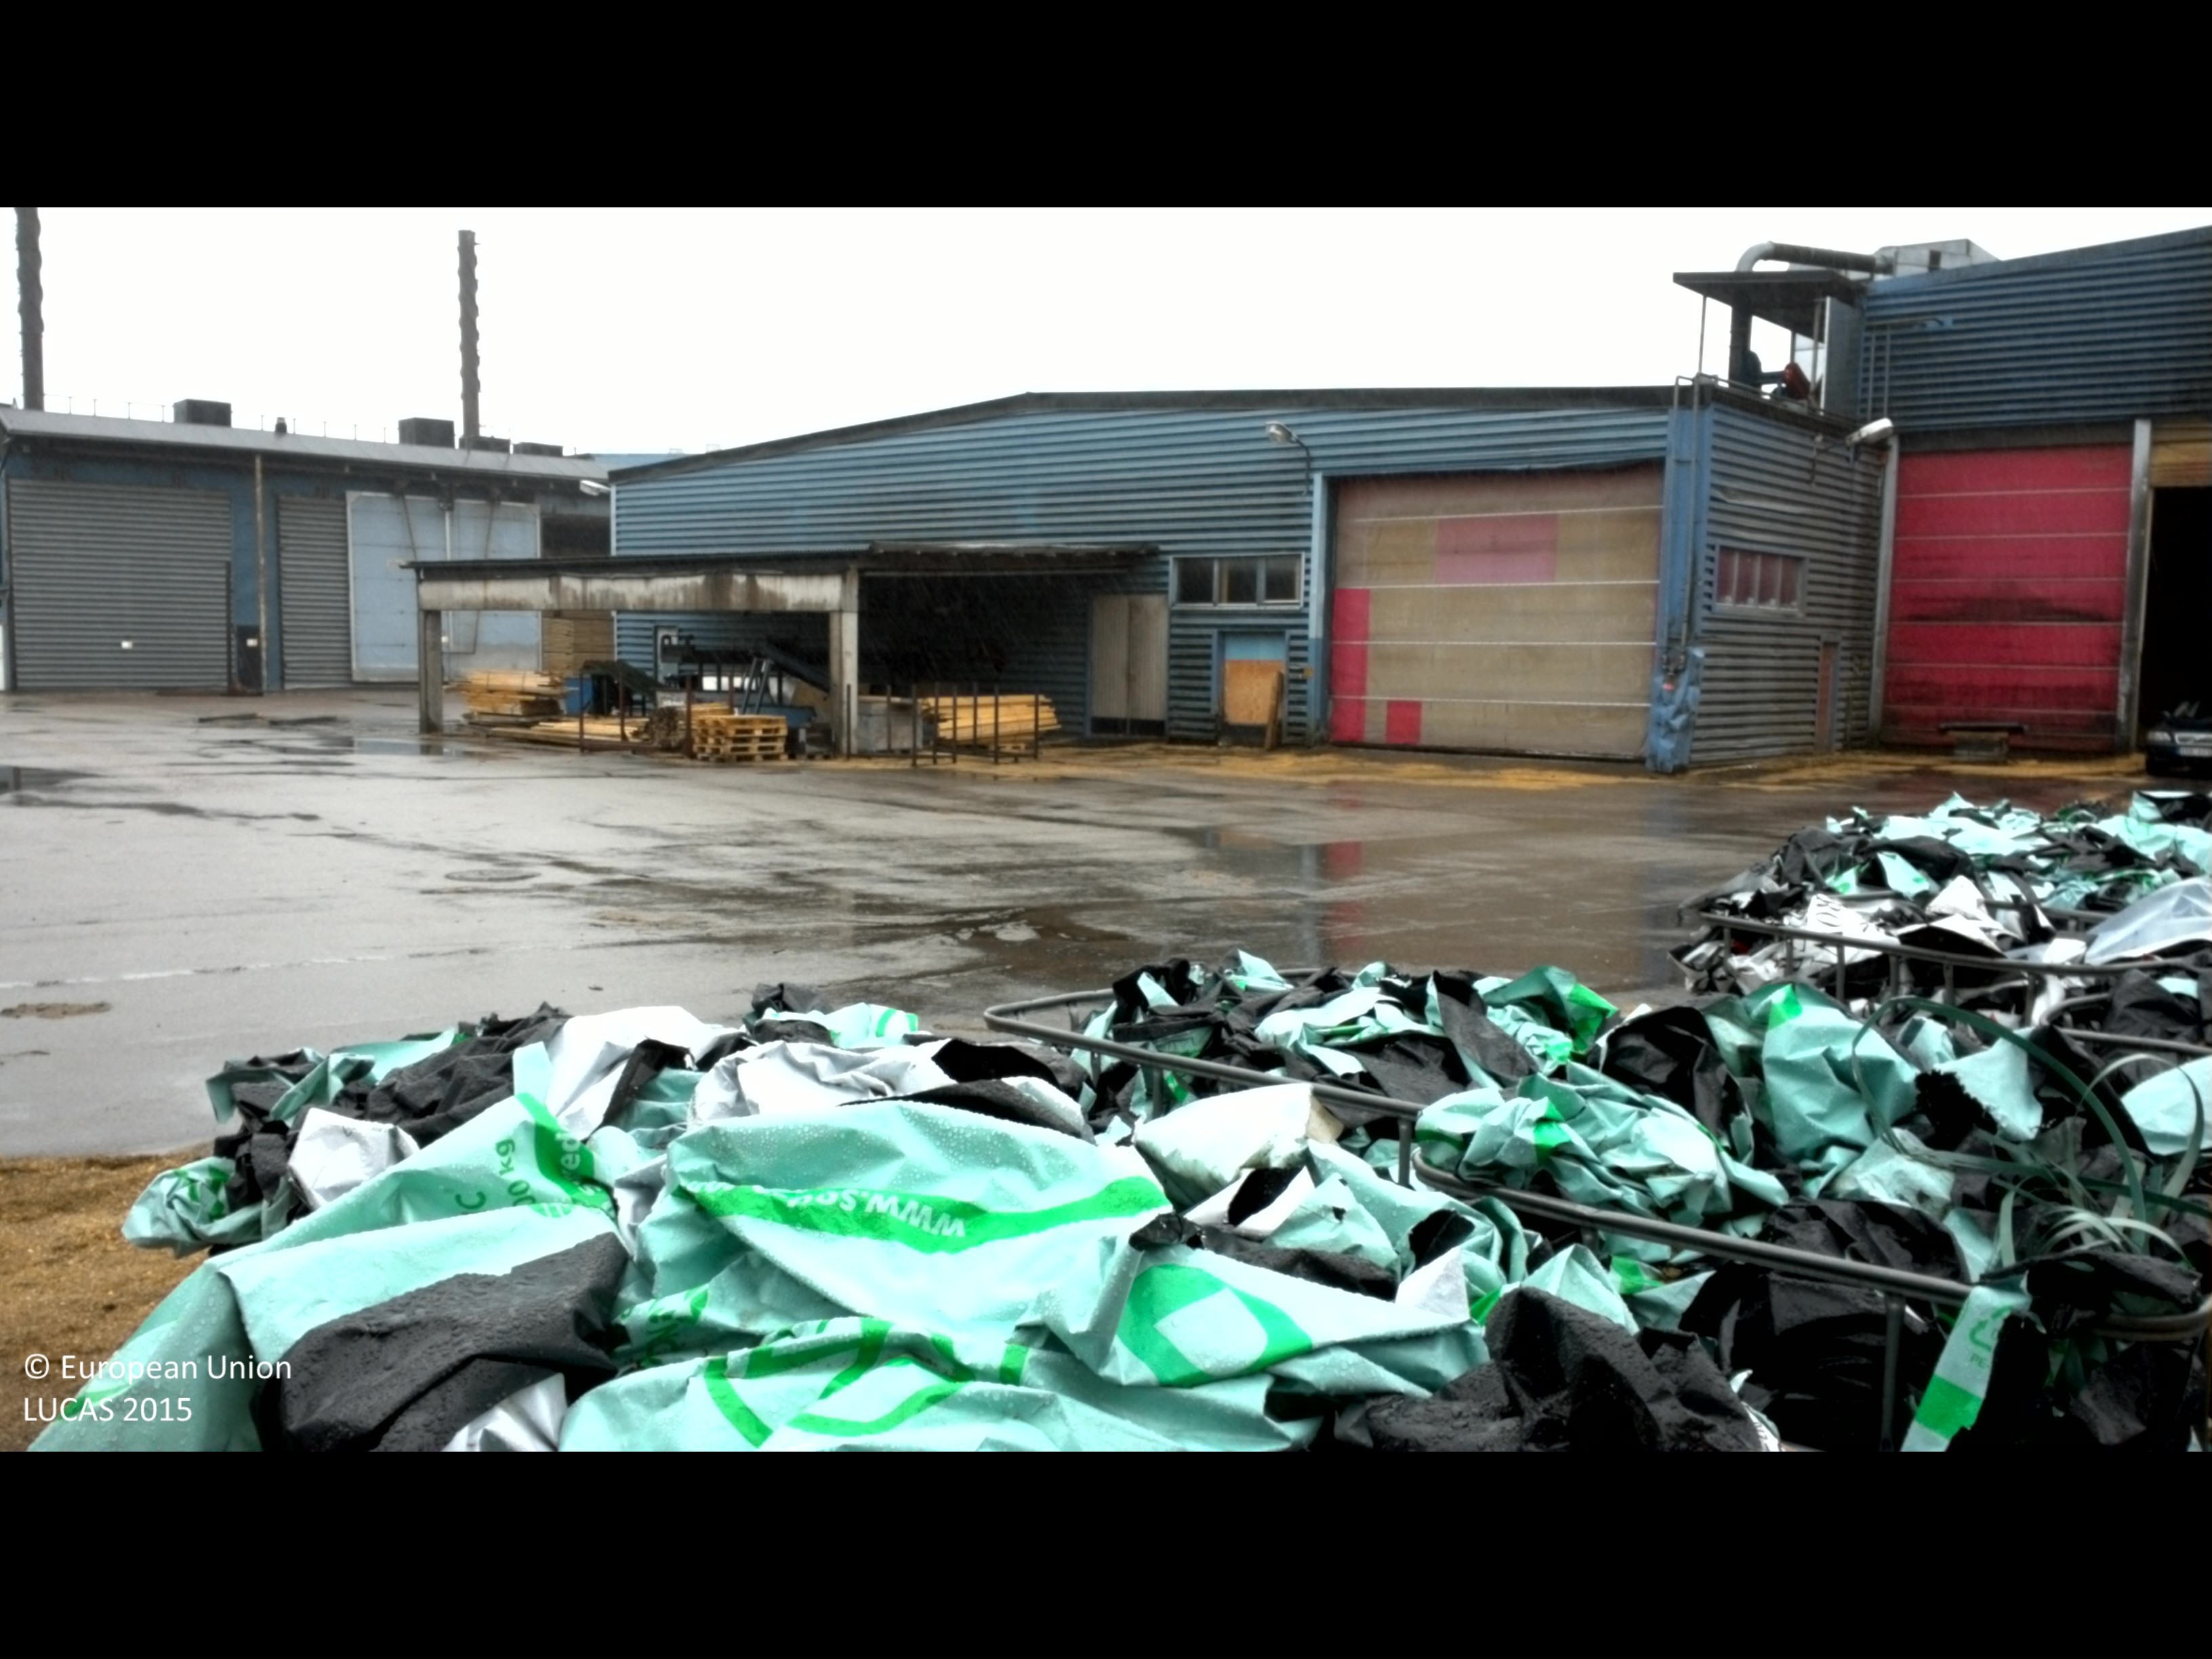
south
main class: Woodland
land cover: Broadleaved woodland
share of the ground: 25 - 50 %
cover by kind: broadleaved forest trees 50 %, herbaceous plants 20 %, lichens and mosses 20 %, unconsolidated bare surface 10 %
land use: Semi-natural and natural areas not in use
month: July
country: SE
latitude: 56.5828
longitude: 13.7578
